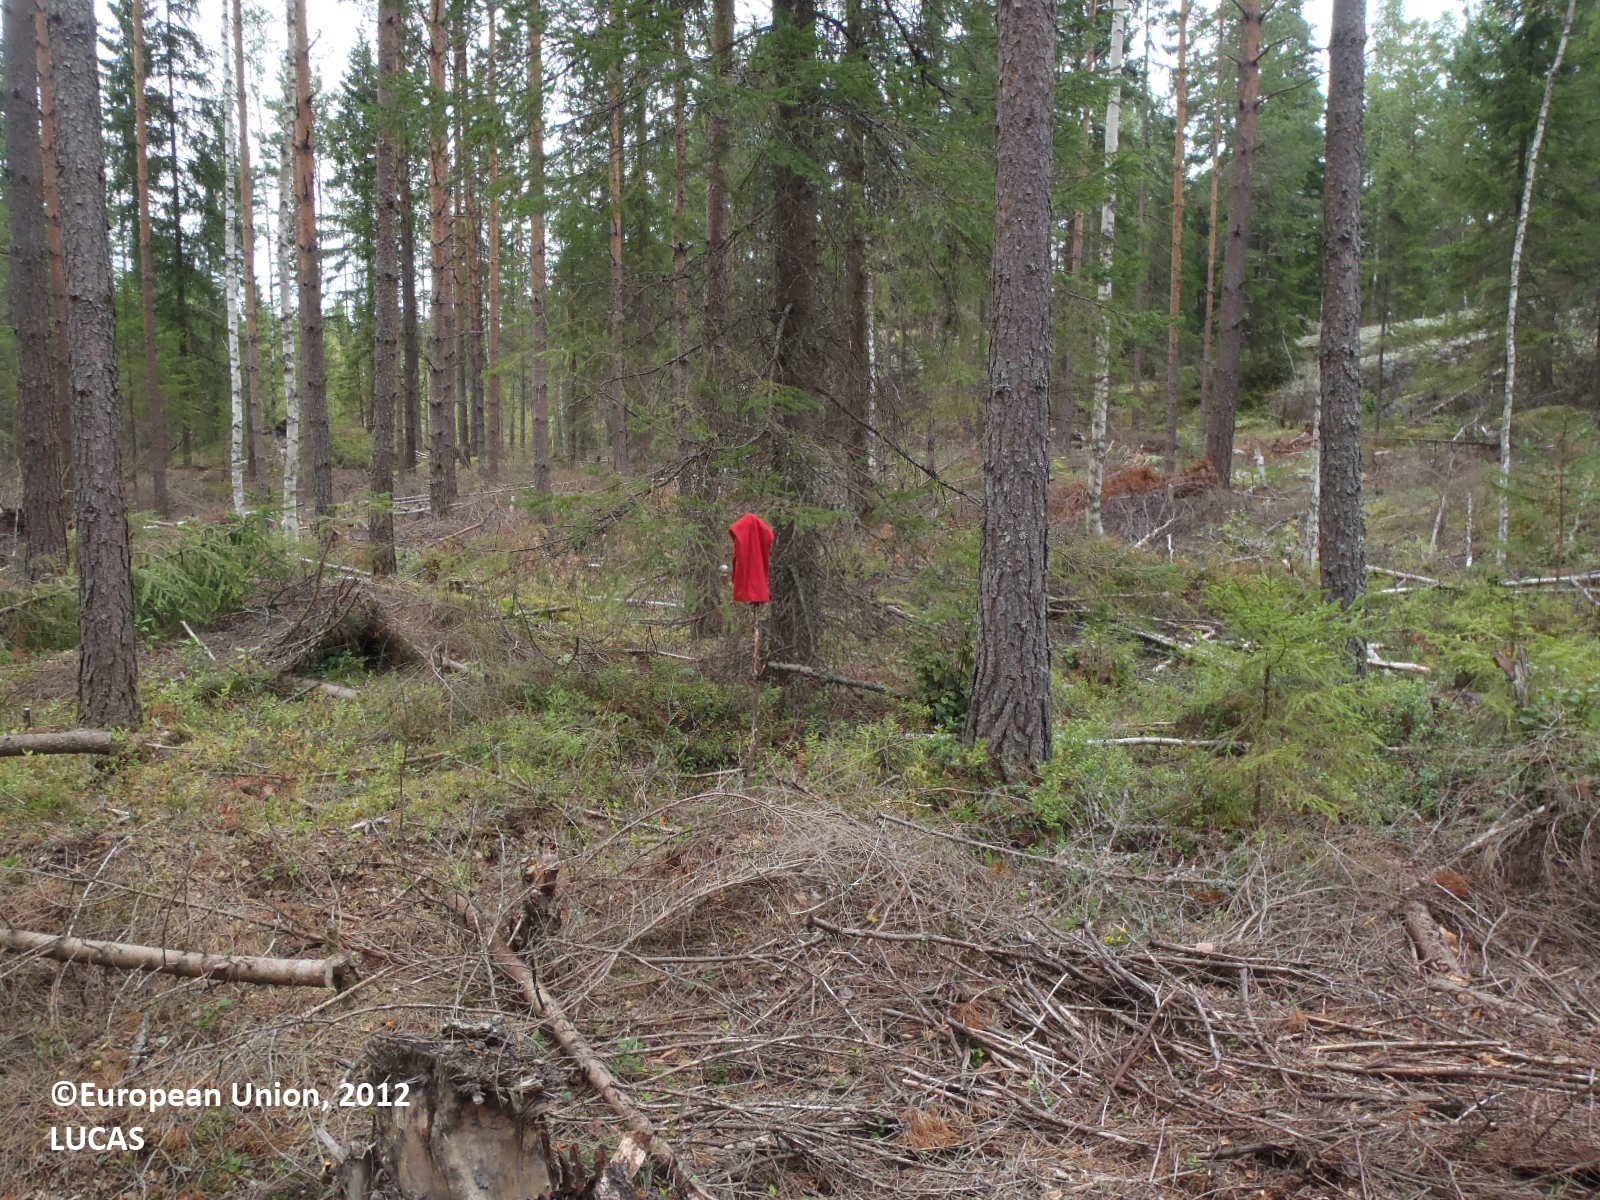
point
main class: Woodland
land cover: Pine dominated mixed woodland
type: boreal forest
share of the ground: > 75 %
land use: Forestry
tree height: > 5 m
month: August
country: FI
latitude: 60.8145
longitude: 22.4396
